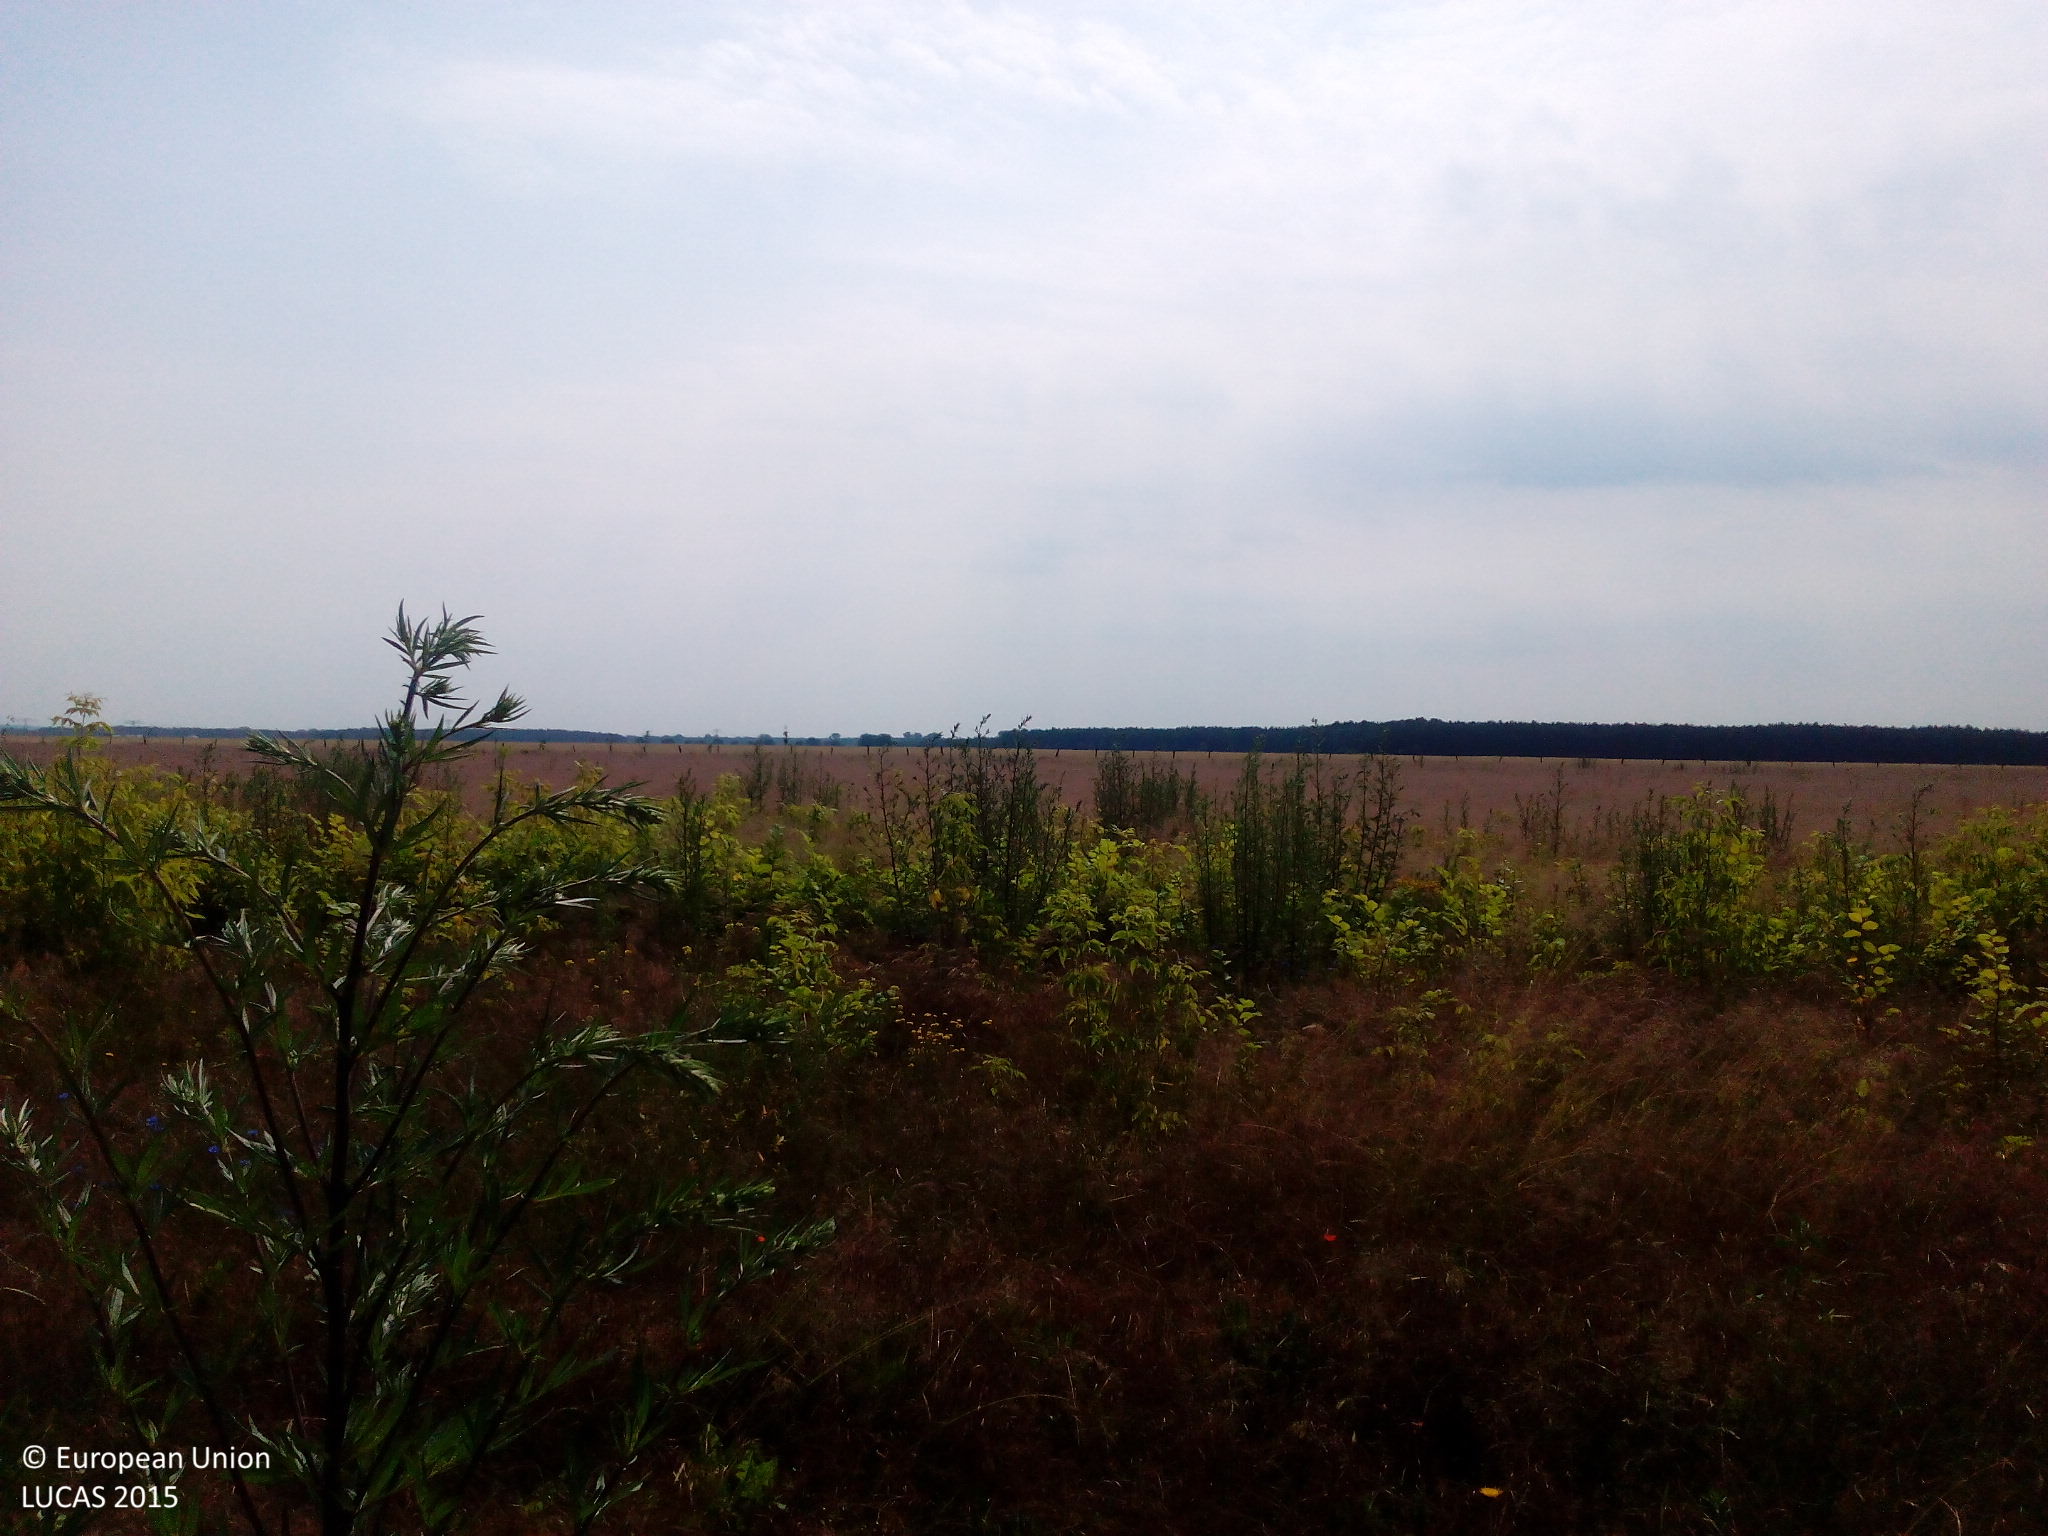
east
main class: Grassland
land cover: Grassland without tree/shrub cover
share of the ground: > 75 %
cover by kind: herbaceous plants 100 %
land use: Agriculture (excluding fallow land and kitchen gardens)
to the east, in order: Grassland without tree/shrub cover
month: June
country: DE
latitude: 51.3563
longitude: 13.4325
